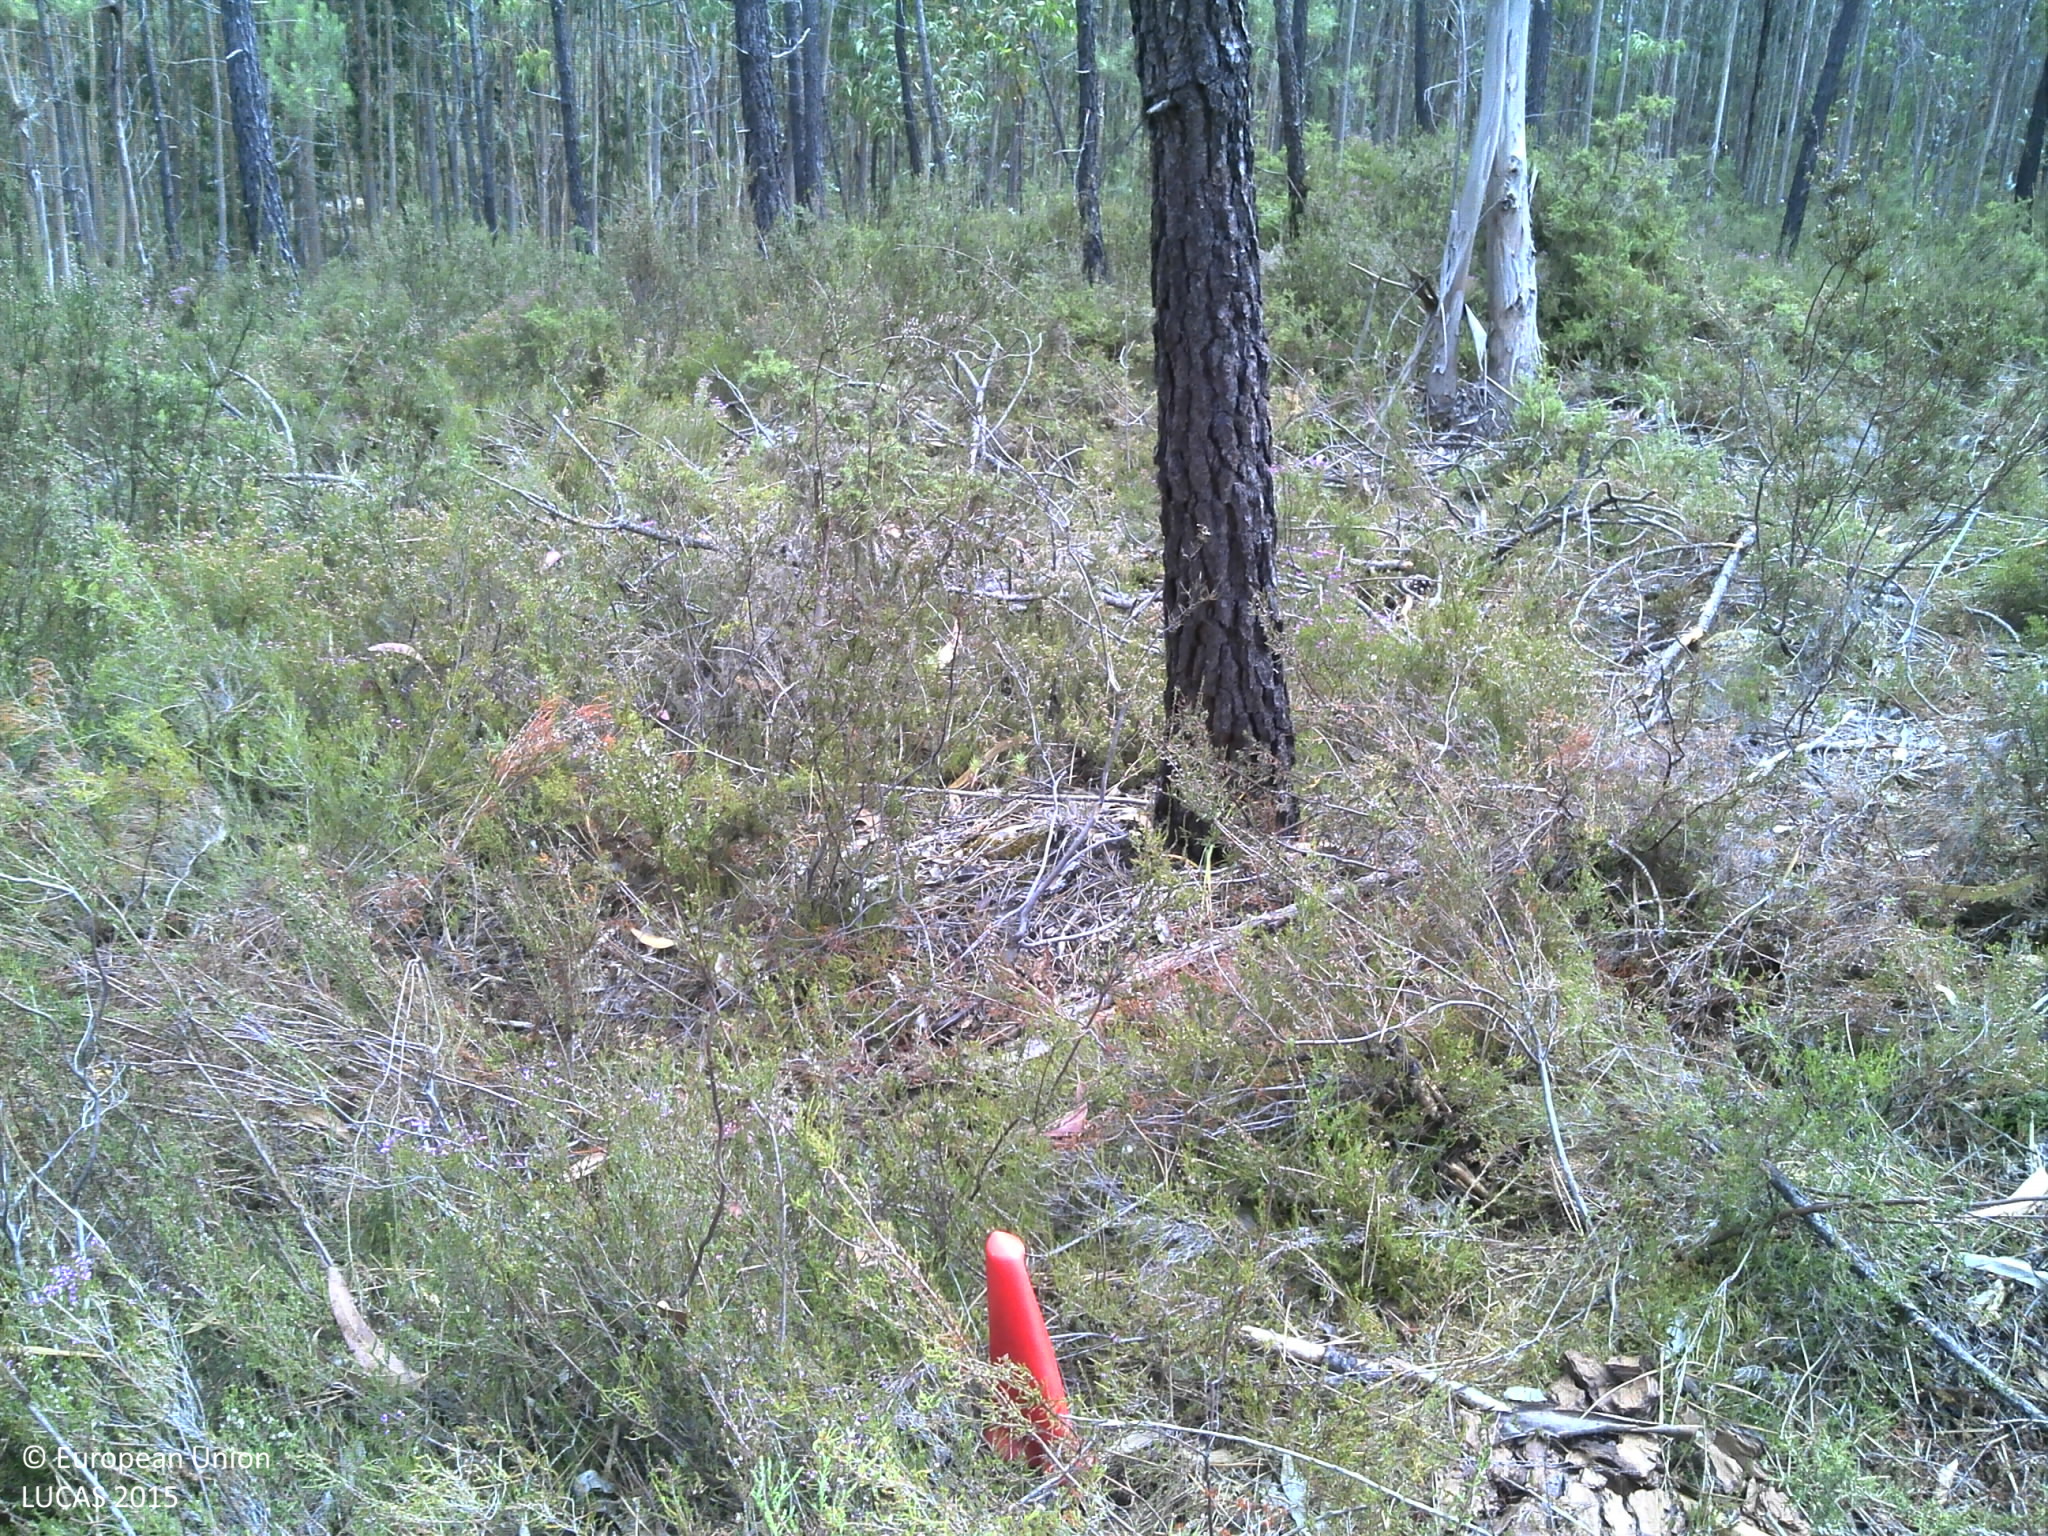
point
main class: Woodland
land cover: Pine dominated coniferous woodland
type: coniferous forest of the mediterranean region
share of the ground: 50 - 75 %
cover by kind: coniferous forest trees 60 %, shrubs 35 %, unconsolidated bare surface 5 %
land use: Forestry
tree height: > 5 m
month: June
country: PT
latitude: 40.4740
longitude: -8.3812
